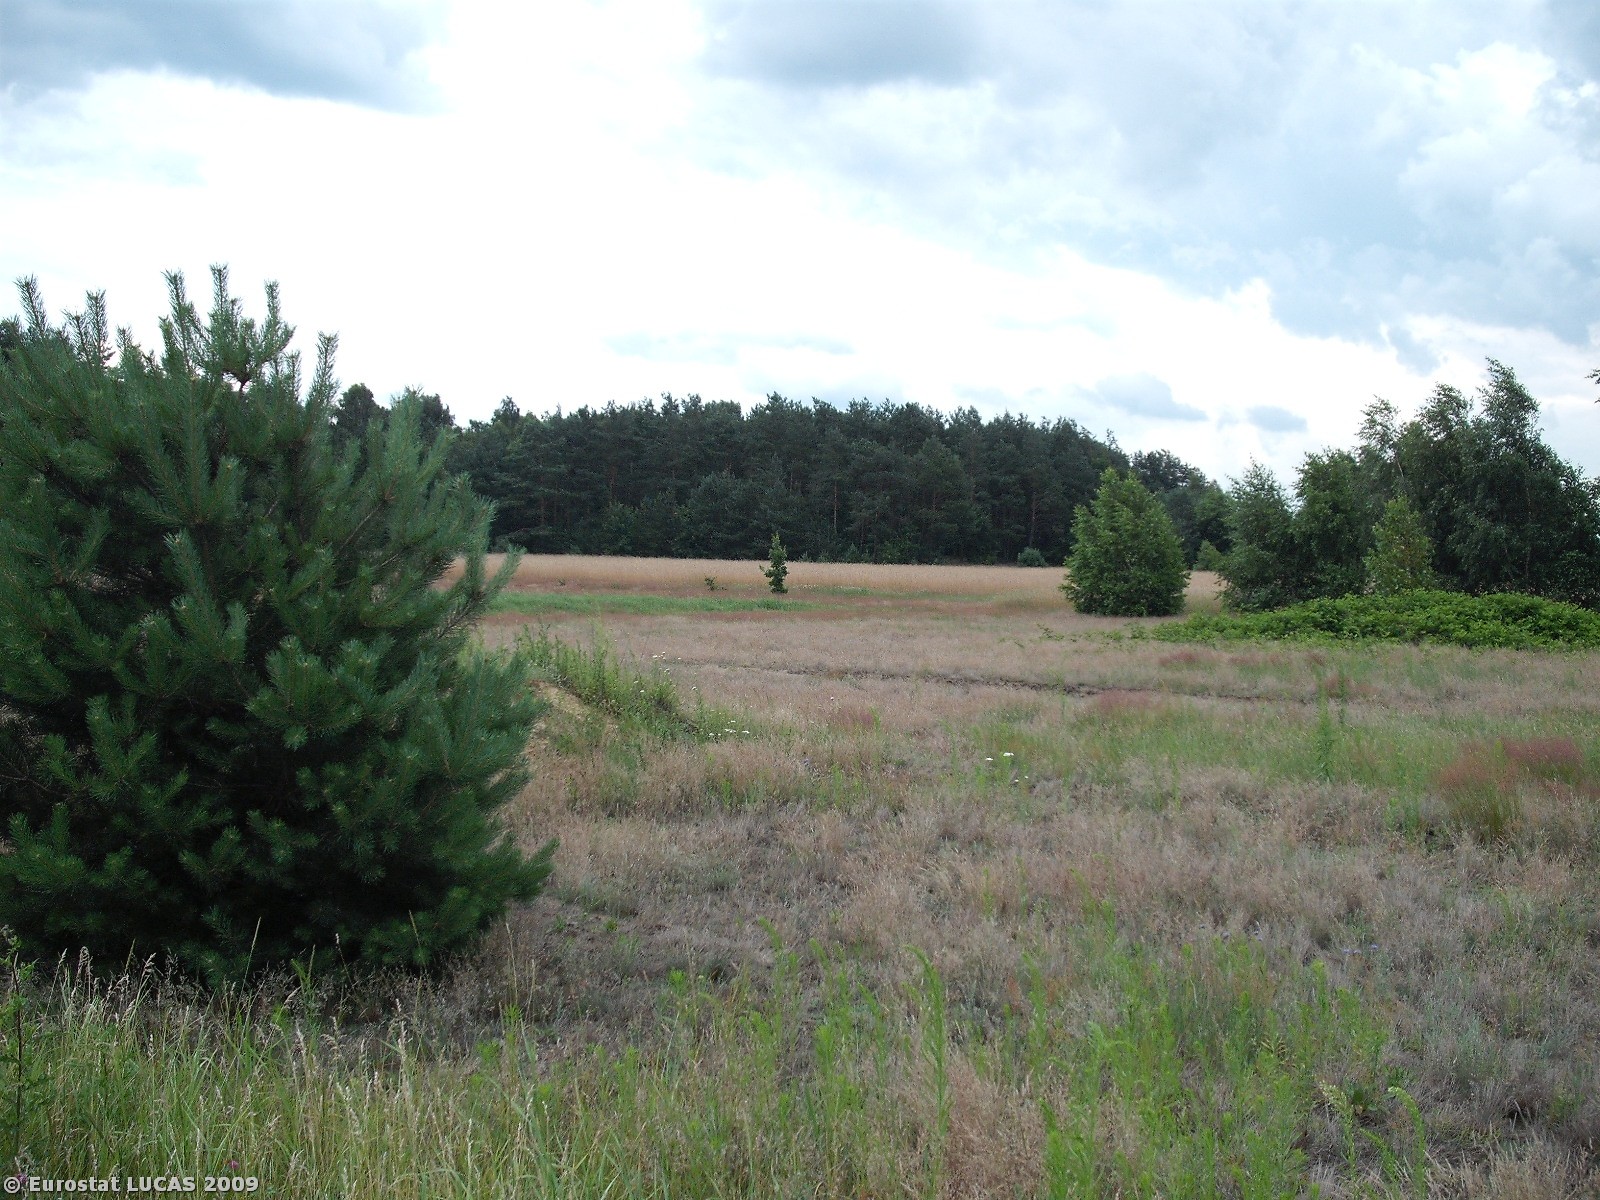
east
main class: Grassland
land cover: Grassland with sparse tree/shrub cover
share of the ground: > 75 %
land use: Unused
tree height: < 5 m
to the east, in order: Grassland with sparse tree/shrub cover; Tracks; Spontaneously vegetated surfaces; Rye; Grass margins; Rye; Grass margins; Rye; Spontaneously vegetated surfaces; Coniferous woodland; Broadleaved woodland
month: July
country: PL
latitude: 51.4777
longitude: 21.0601
